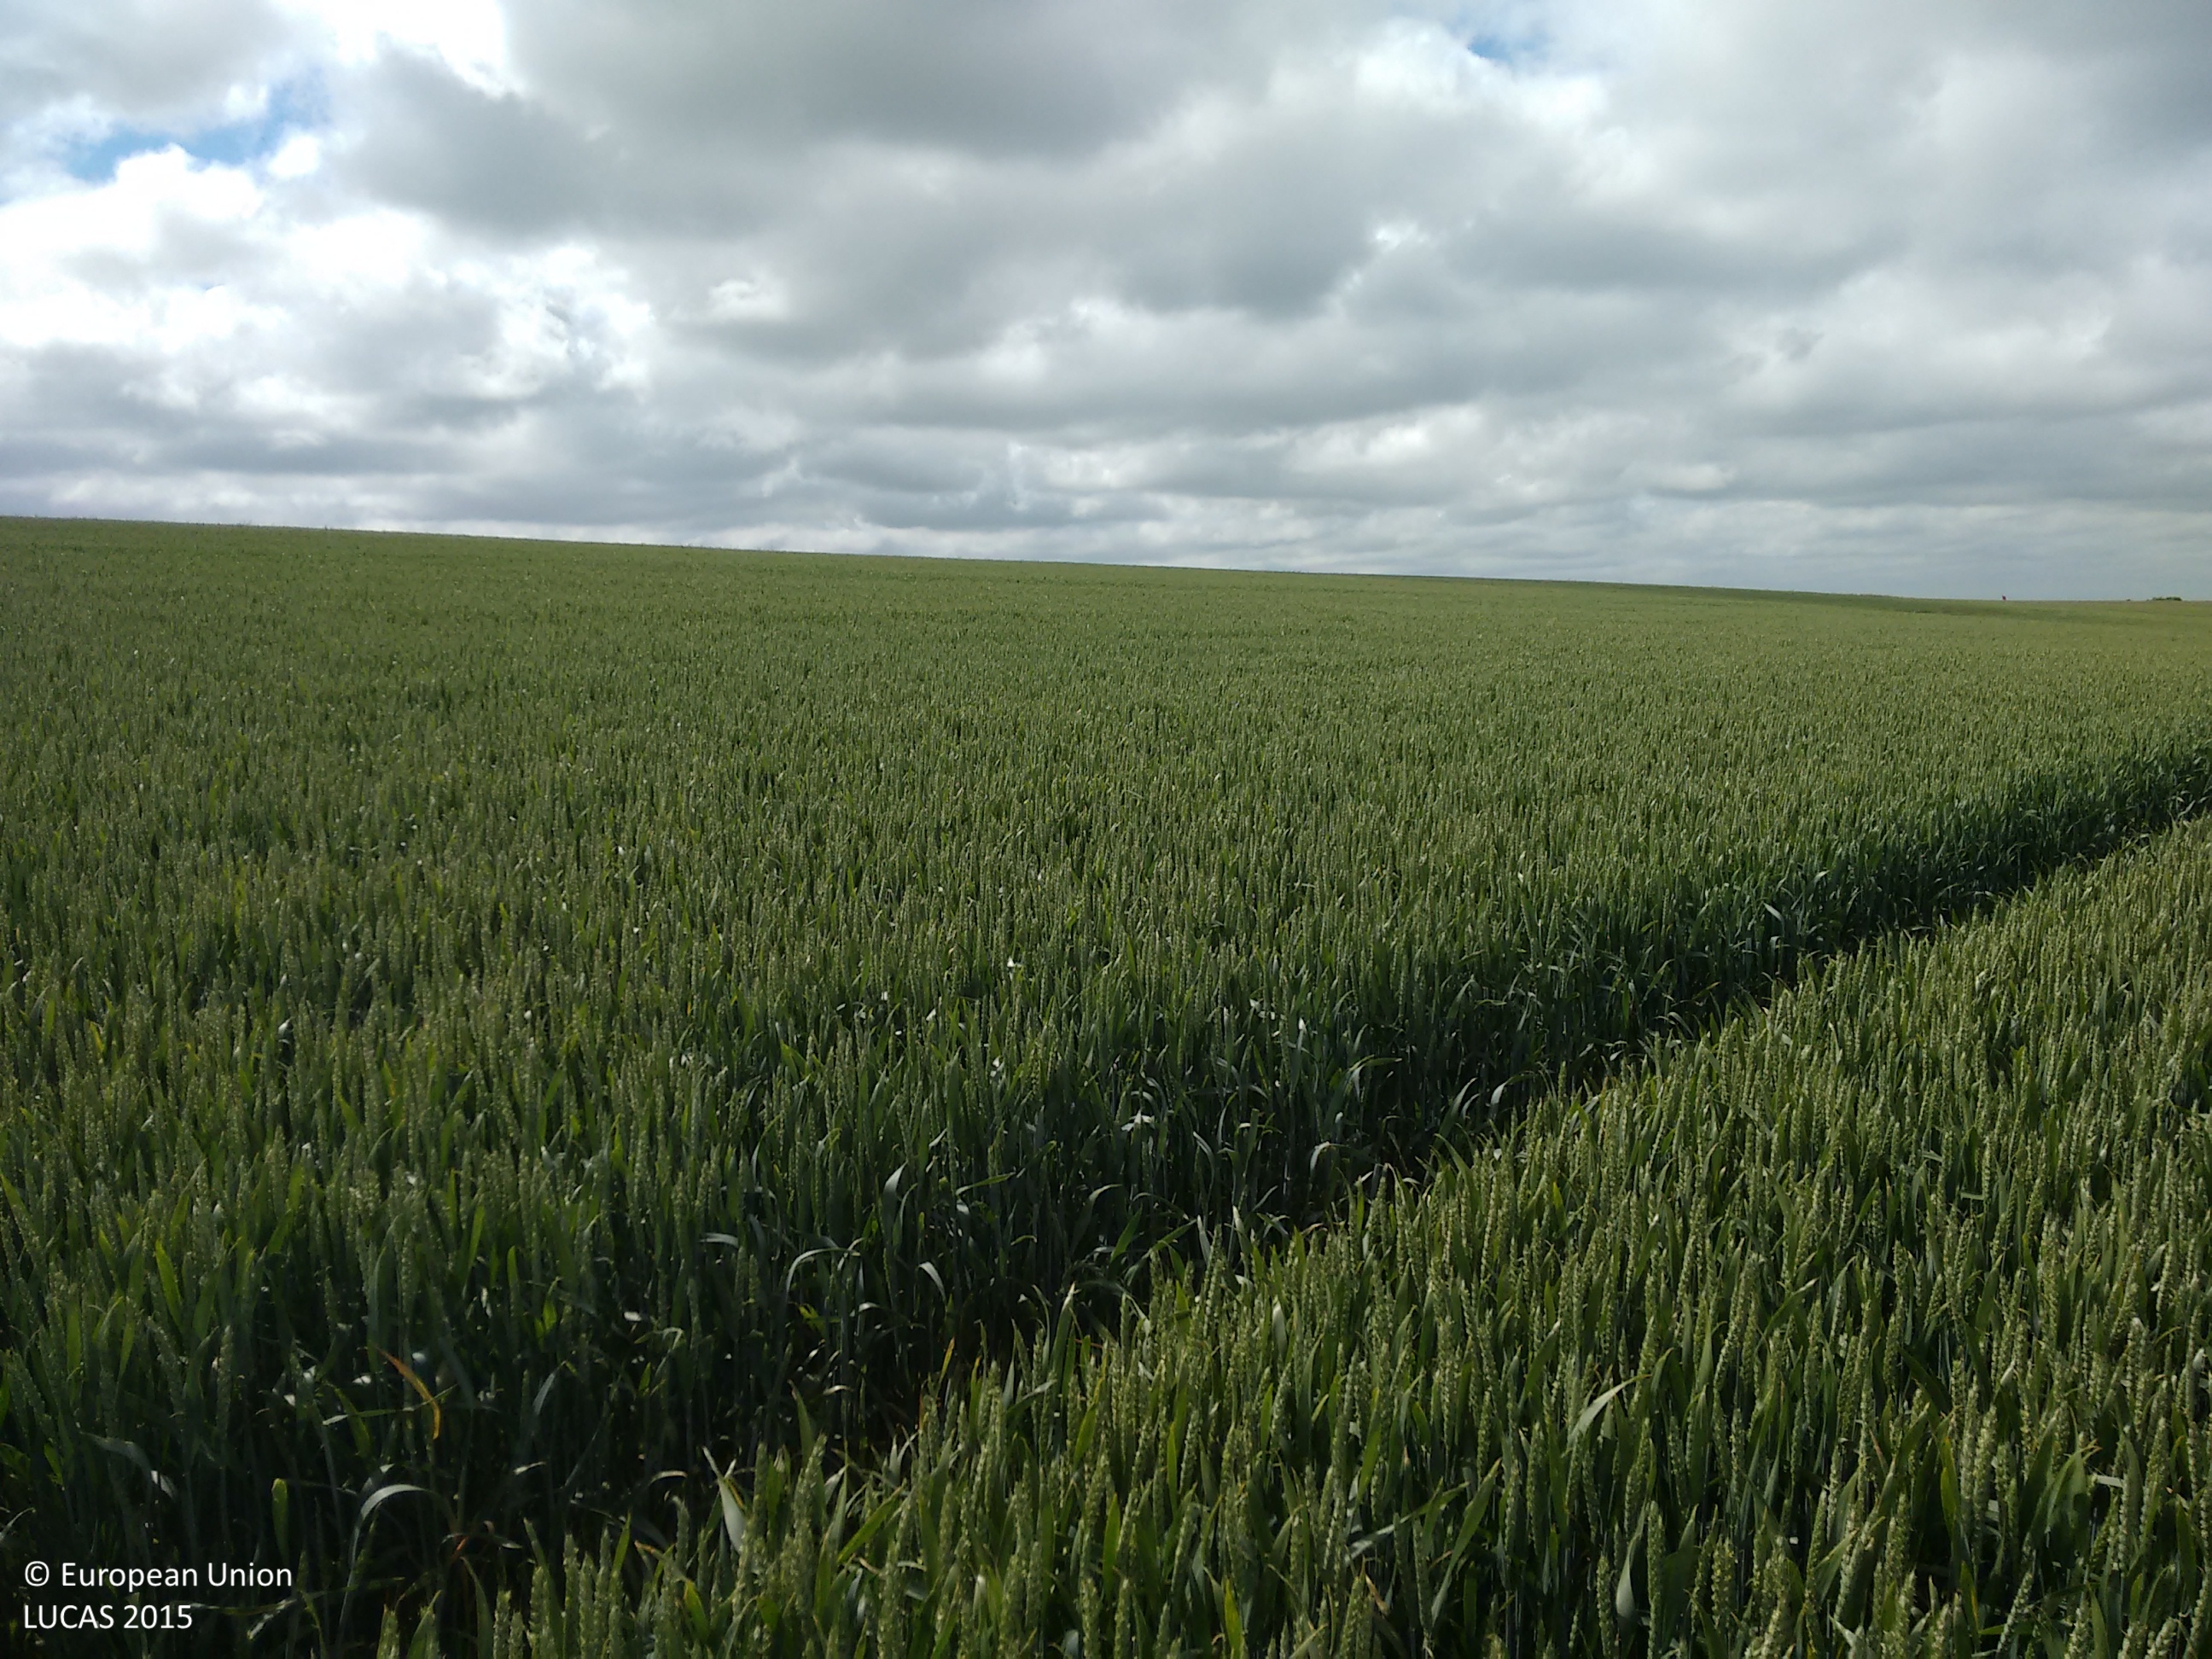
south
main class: Cropland
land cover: Common wheat
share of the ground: > 75 %
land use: Agriculture (excluding fallow land and kitchen gardens)
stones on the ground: 25 - 50 %
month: June
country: GB
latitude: 51.2781
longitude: -1.9711
